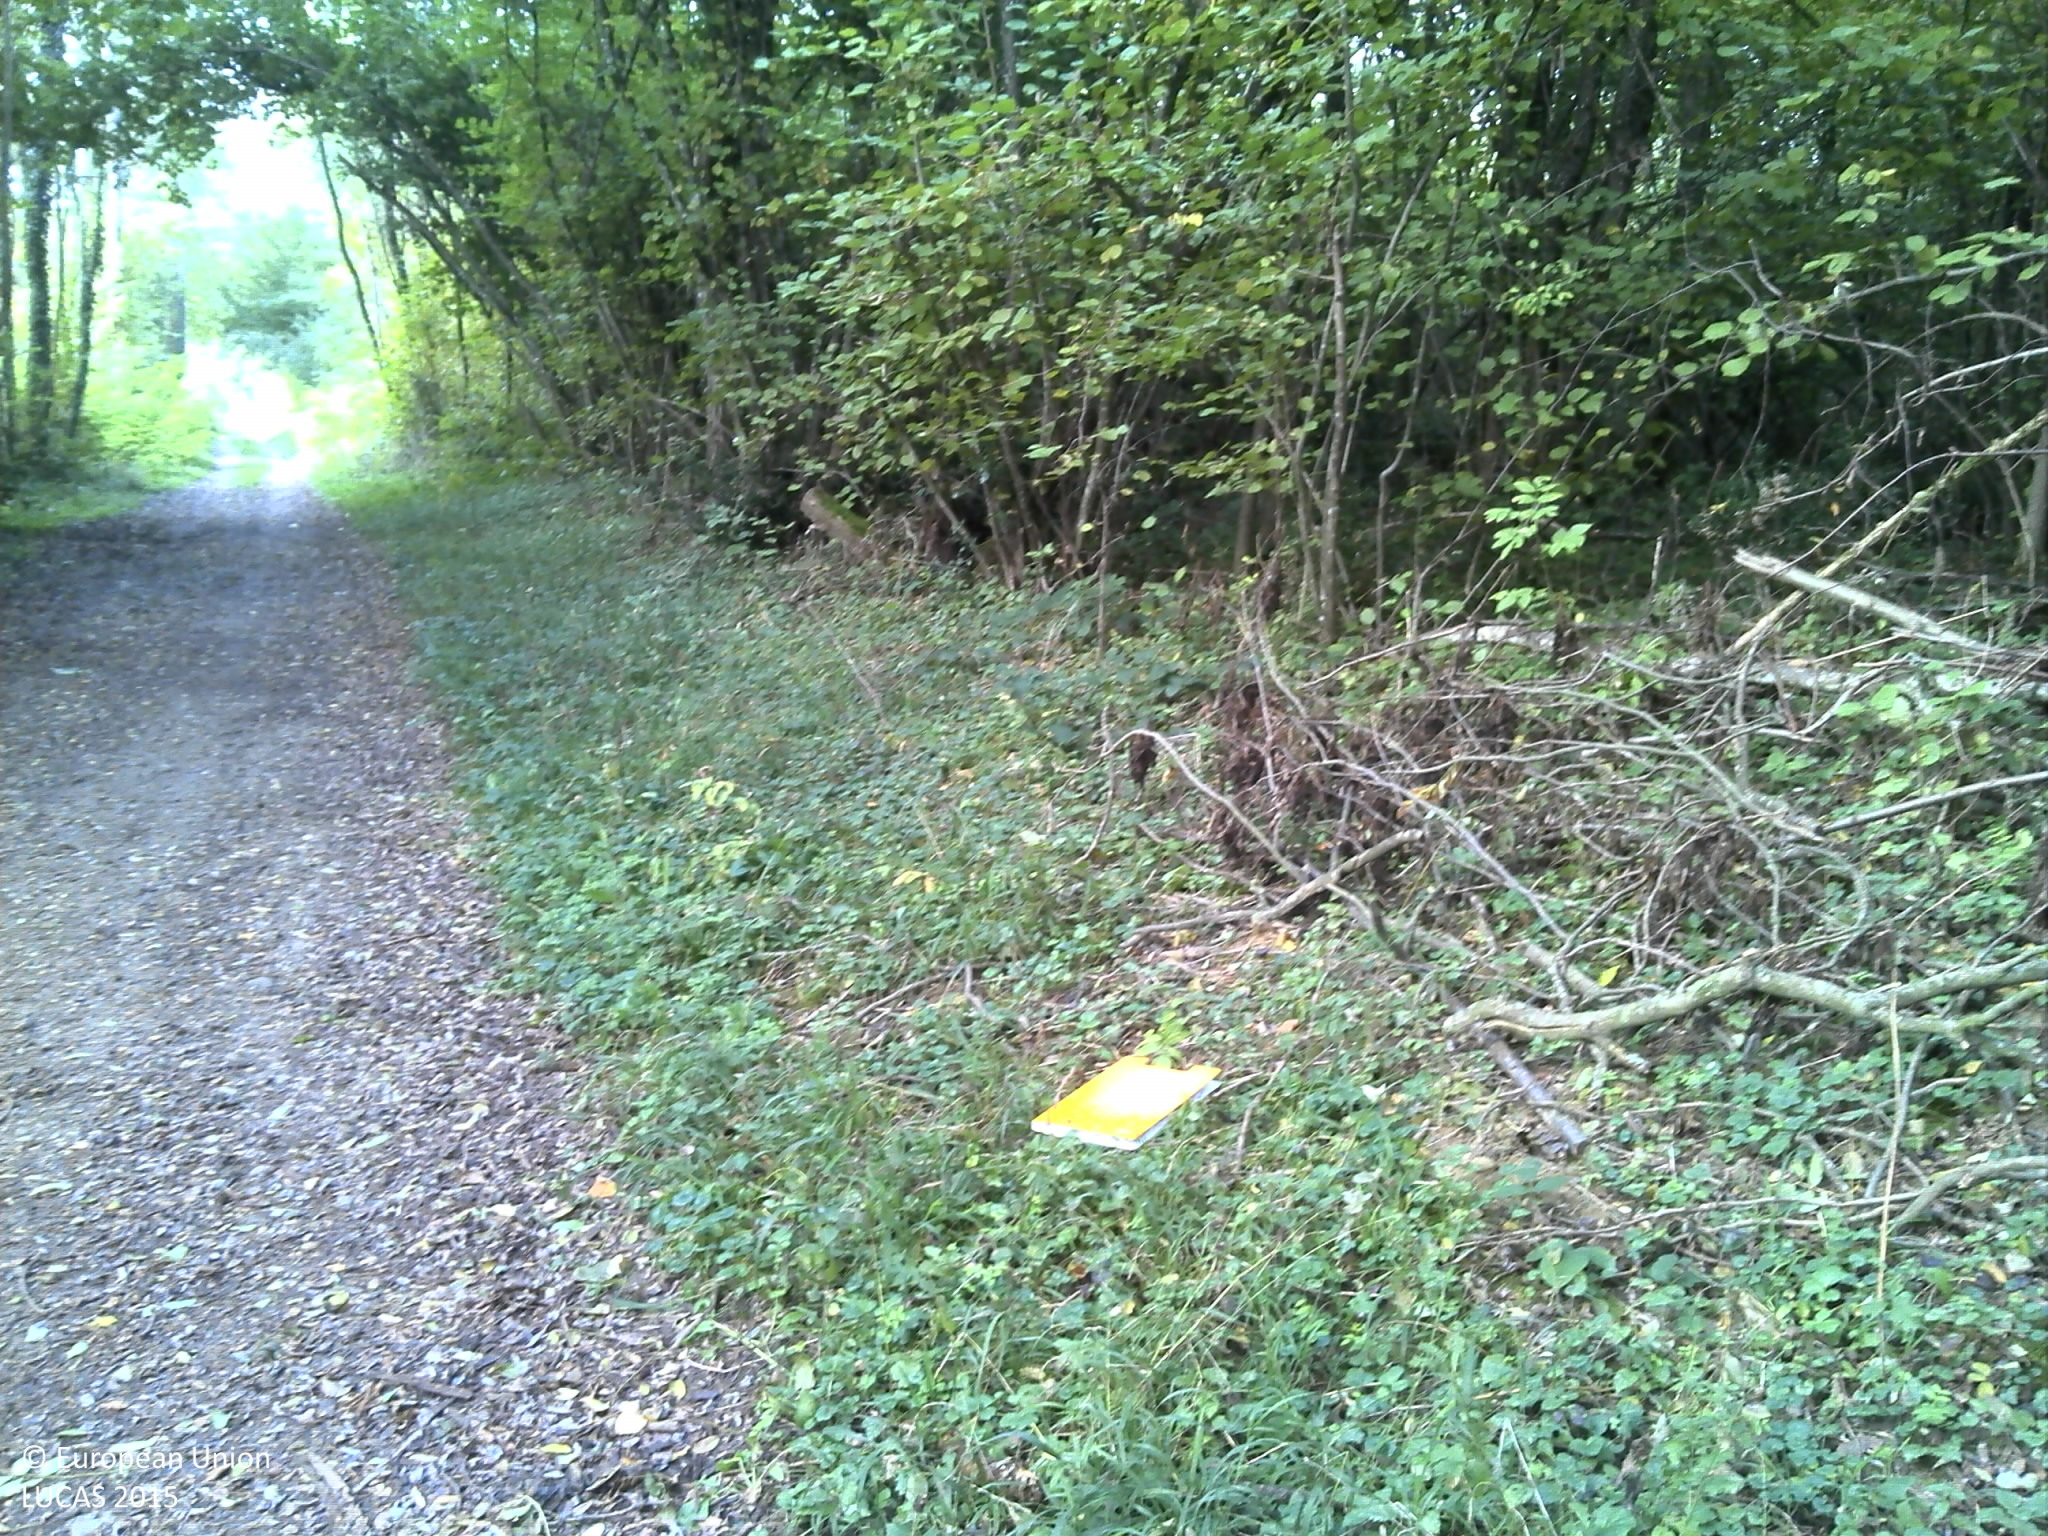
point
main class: Woodland
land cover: Broadleaved woodland
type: mesophytic deciduous forest
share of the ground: > 75 %
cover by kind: broadleaved forest trees 90 %, herbaceous plants 5 %, unconsolidated bare surface 5 %
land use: Forestry
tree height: > 5 m
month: October
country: FR
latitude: 45.9433
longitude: 5.3470
